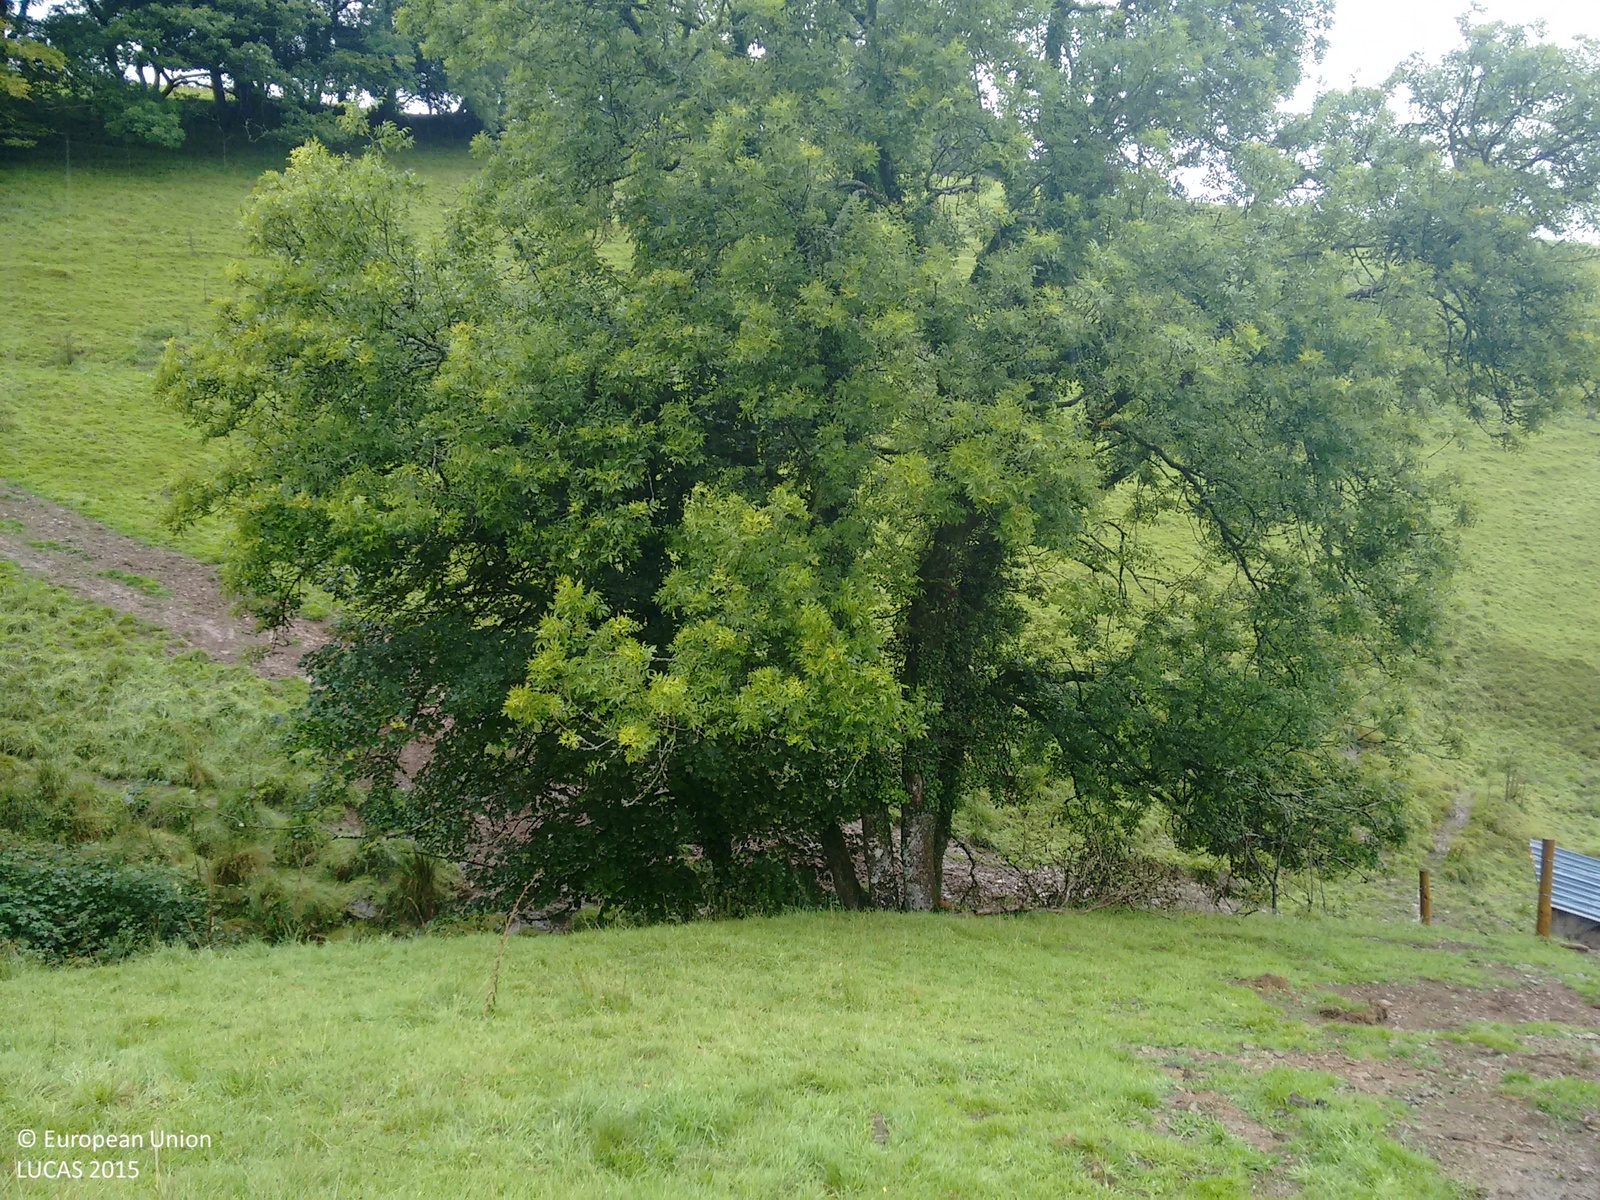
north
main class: Grassland
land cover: Grassland without tree/shrub cover
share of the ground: > 75 %
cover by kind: herbaceous plants 100 %
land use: Agriculture (excluding fallow land and kitchen gardens)
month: August
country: GB
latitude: 51.0854
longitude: -3.5474
